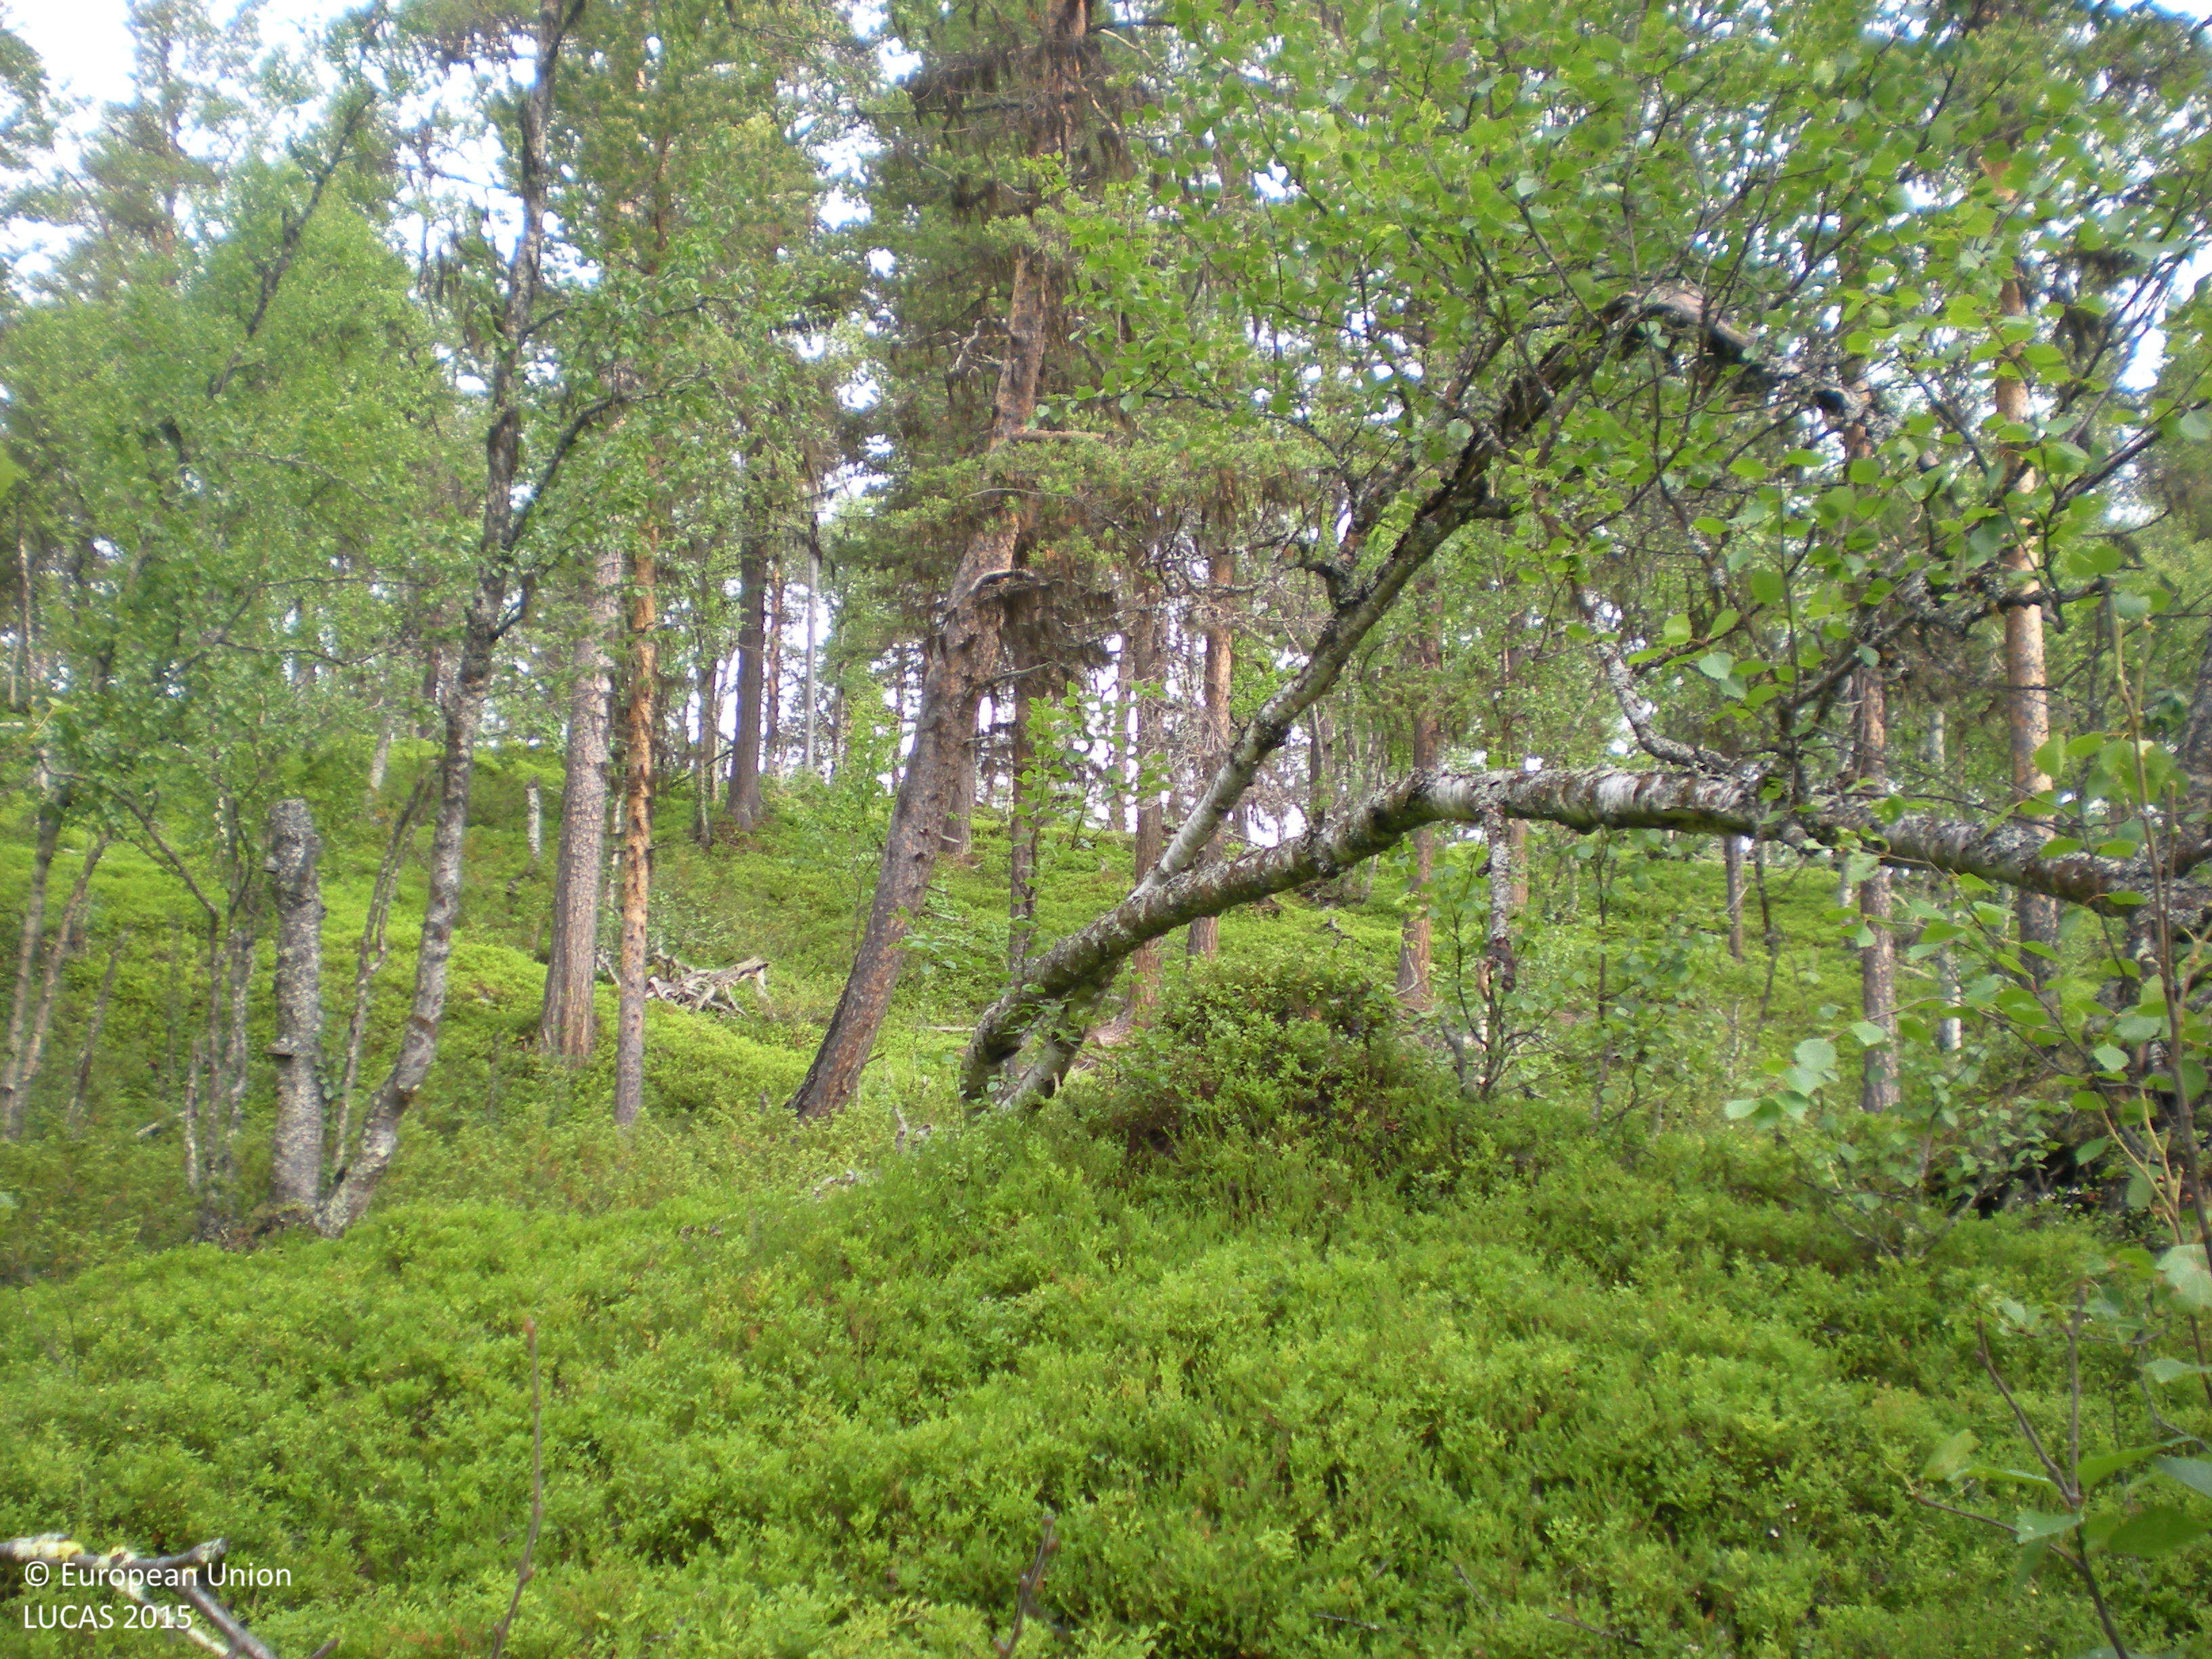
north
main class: Woodland
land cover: Pine dominated mixed woodland
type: boreal forest
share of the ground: 50 - 75 %
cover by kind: coniferous forest trees 45 %, shrubs 25 %, broadleaved forest trees 20 %, lichens and mosses 10 %
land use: Semi-natural and natural areas not in use
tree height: > 5 m
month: August
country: SE
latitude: 66.4273
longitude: 16.8782
